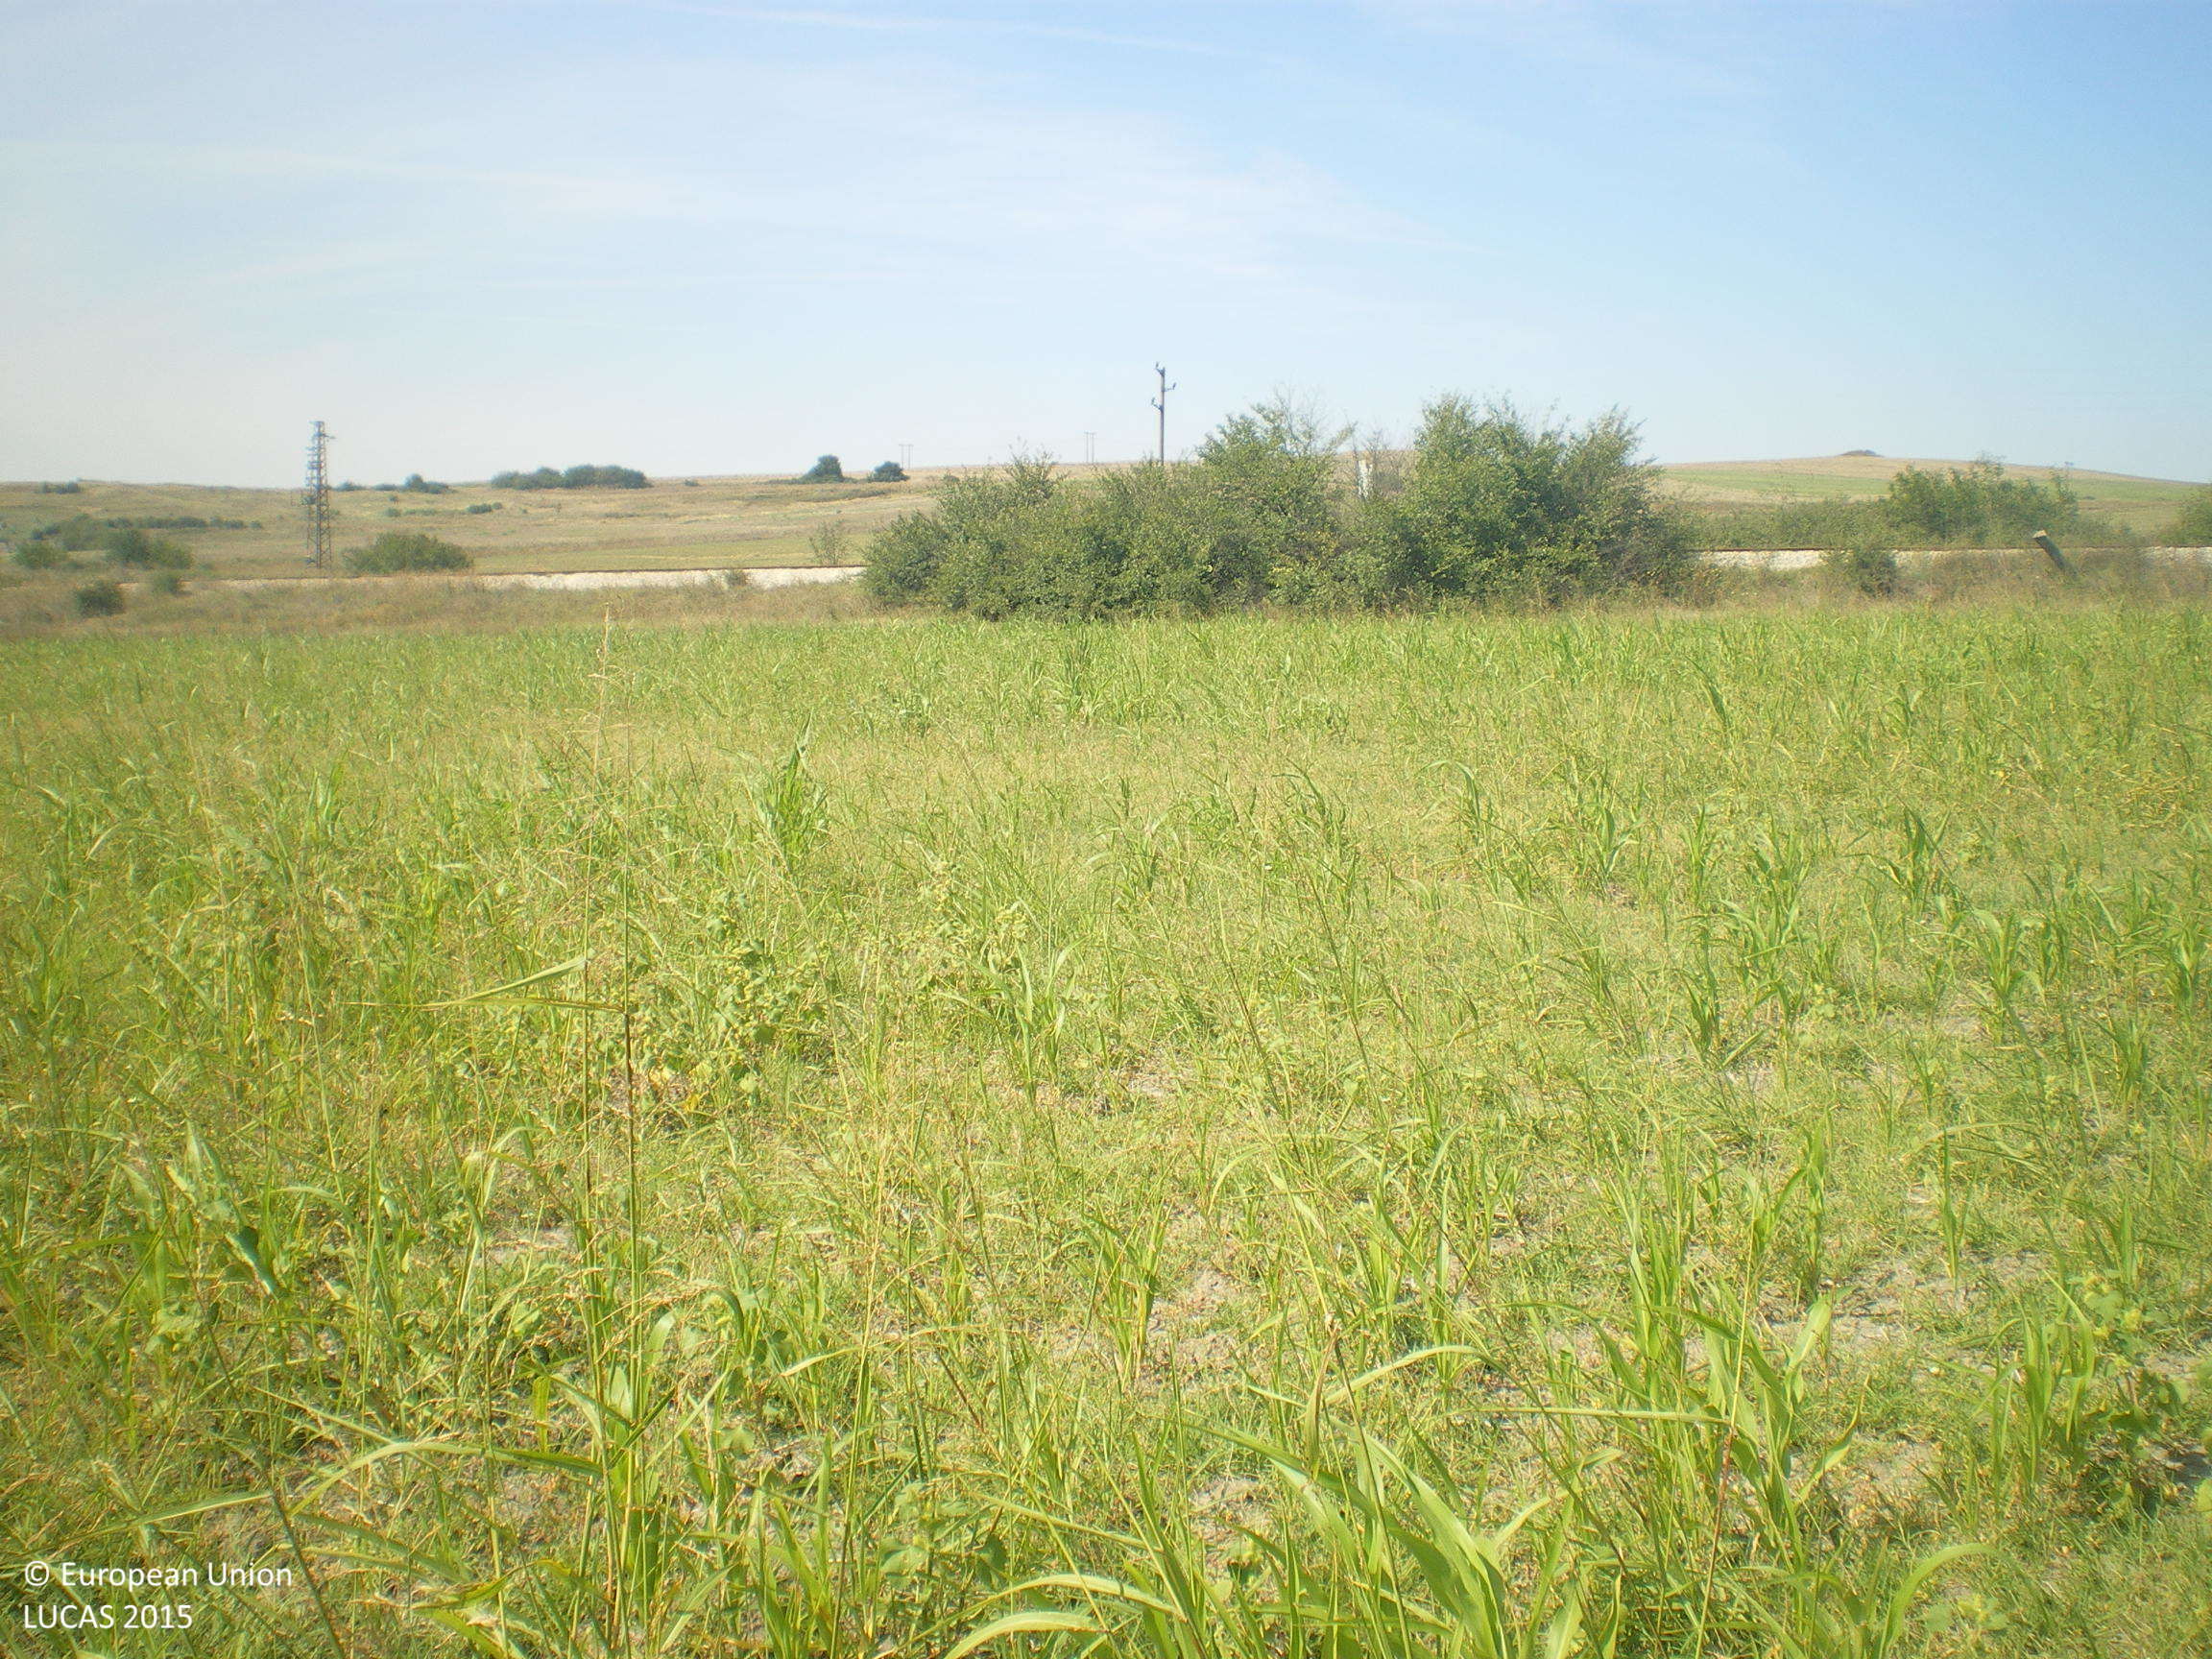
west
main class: Cropland
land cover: Maize
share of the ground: < 10 %
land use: Agriculture (excluding fallow land and kitchen gardens)
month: September
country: BG
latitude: 42.1651
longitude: 25.8697
